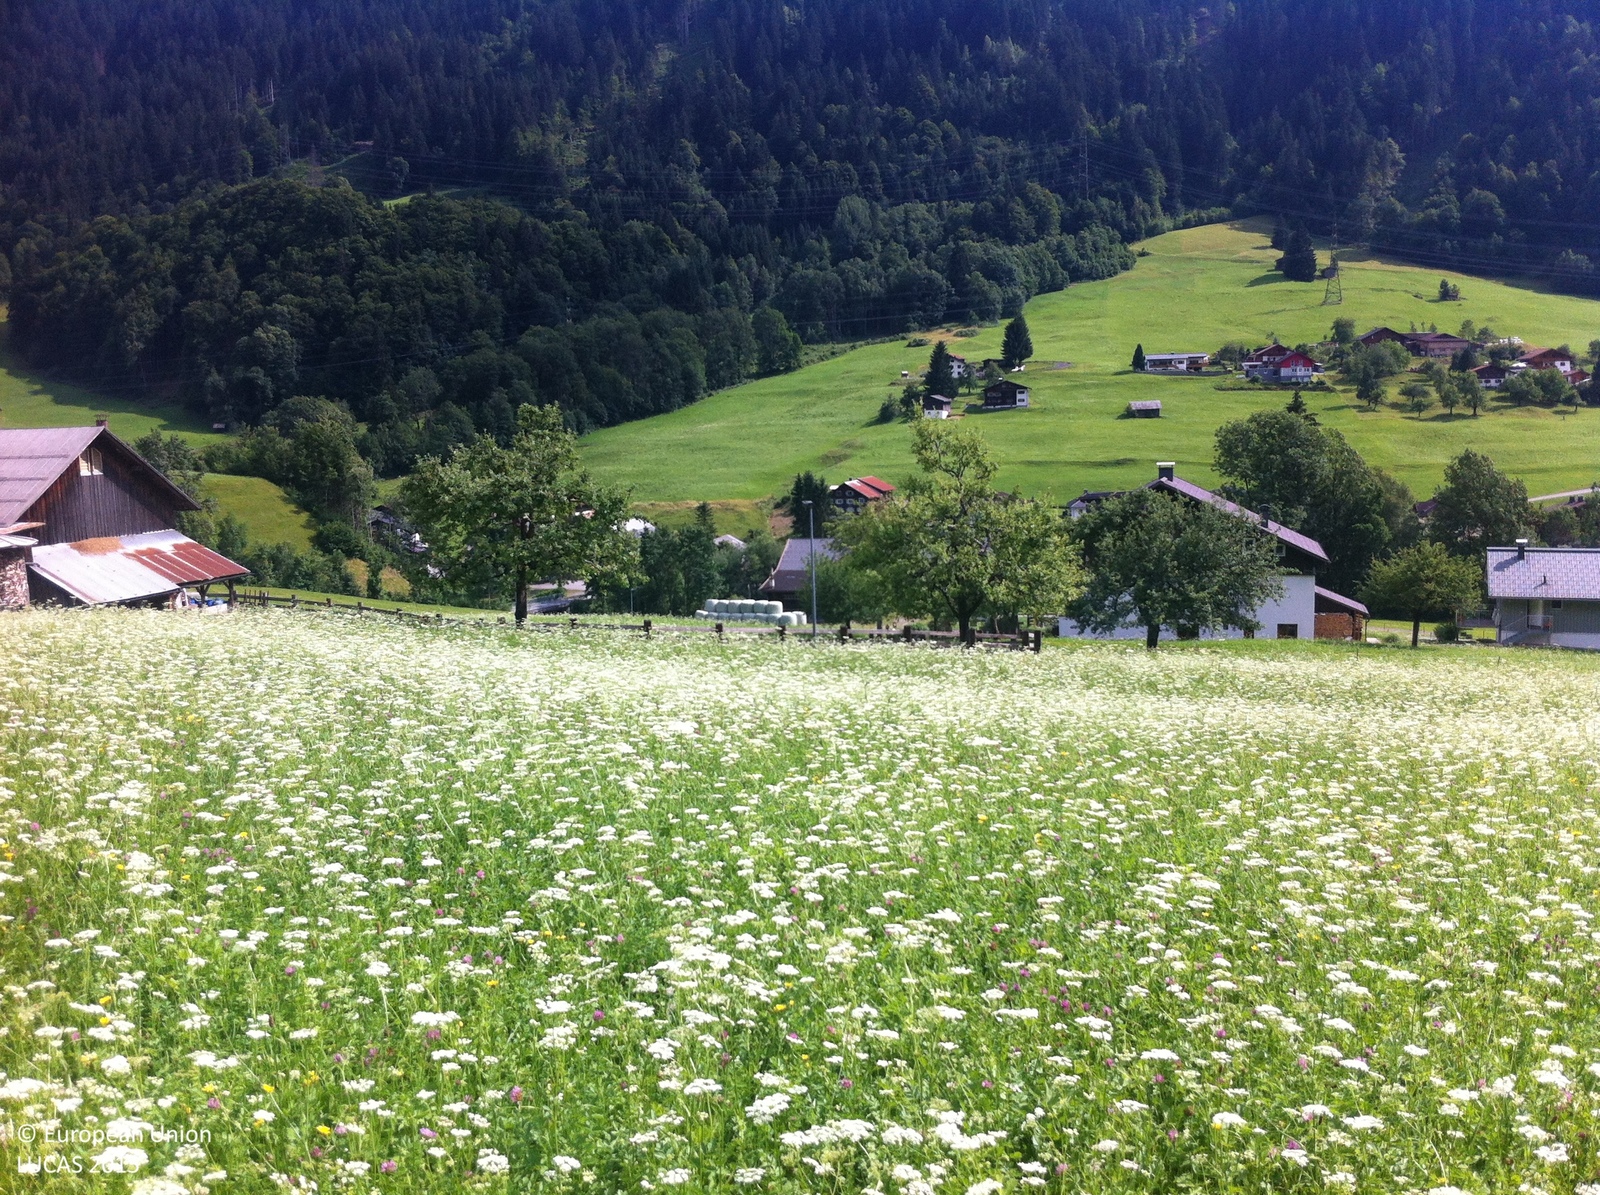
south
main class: Grassland
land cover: Grassland without tree/shrub cover
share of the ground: > 75 %
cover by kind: herbaceous plants 100 %
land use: Agriculture (excluding fallow land and kitchen gardens)
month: July
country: AT
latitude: 47.1255
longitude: 9.9868
